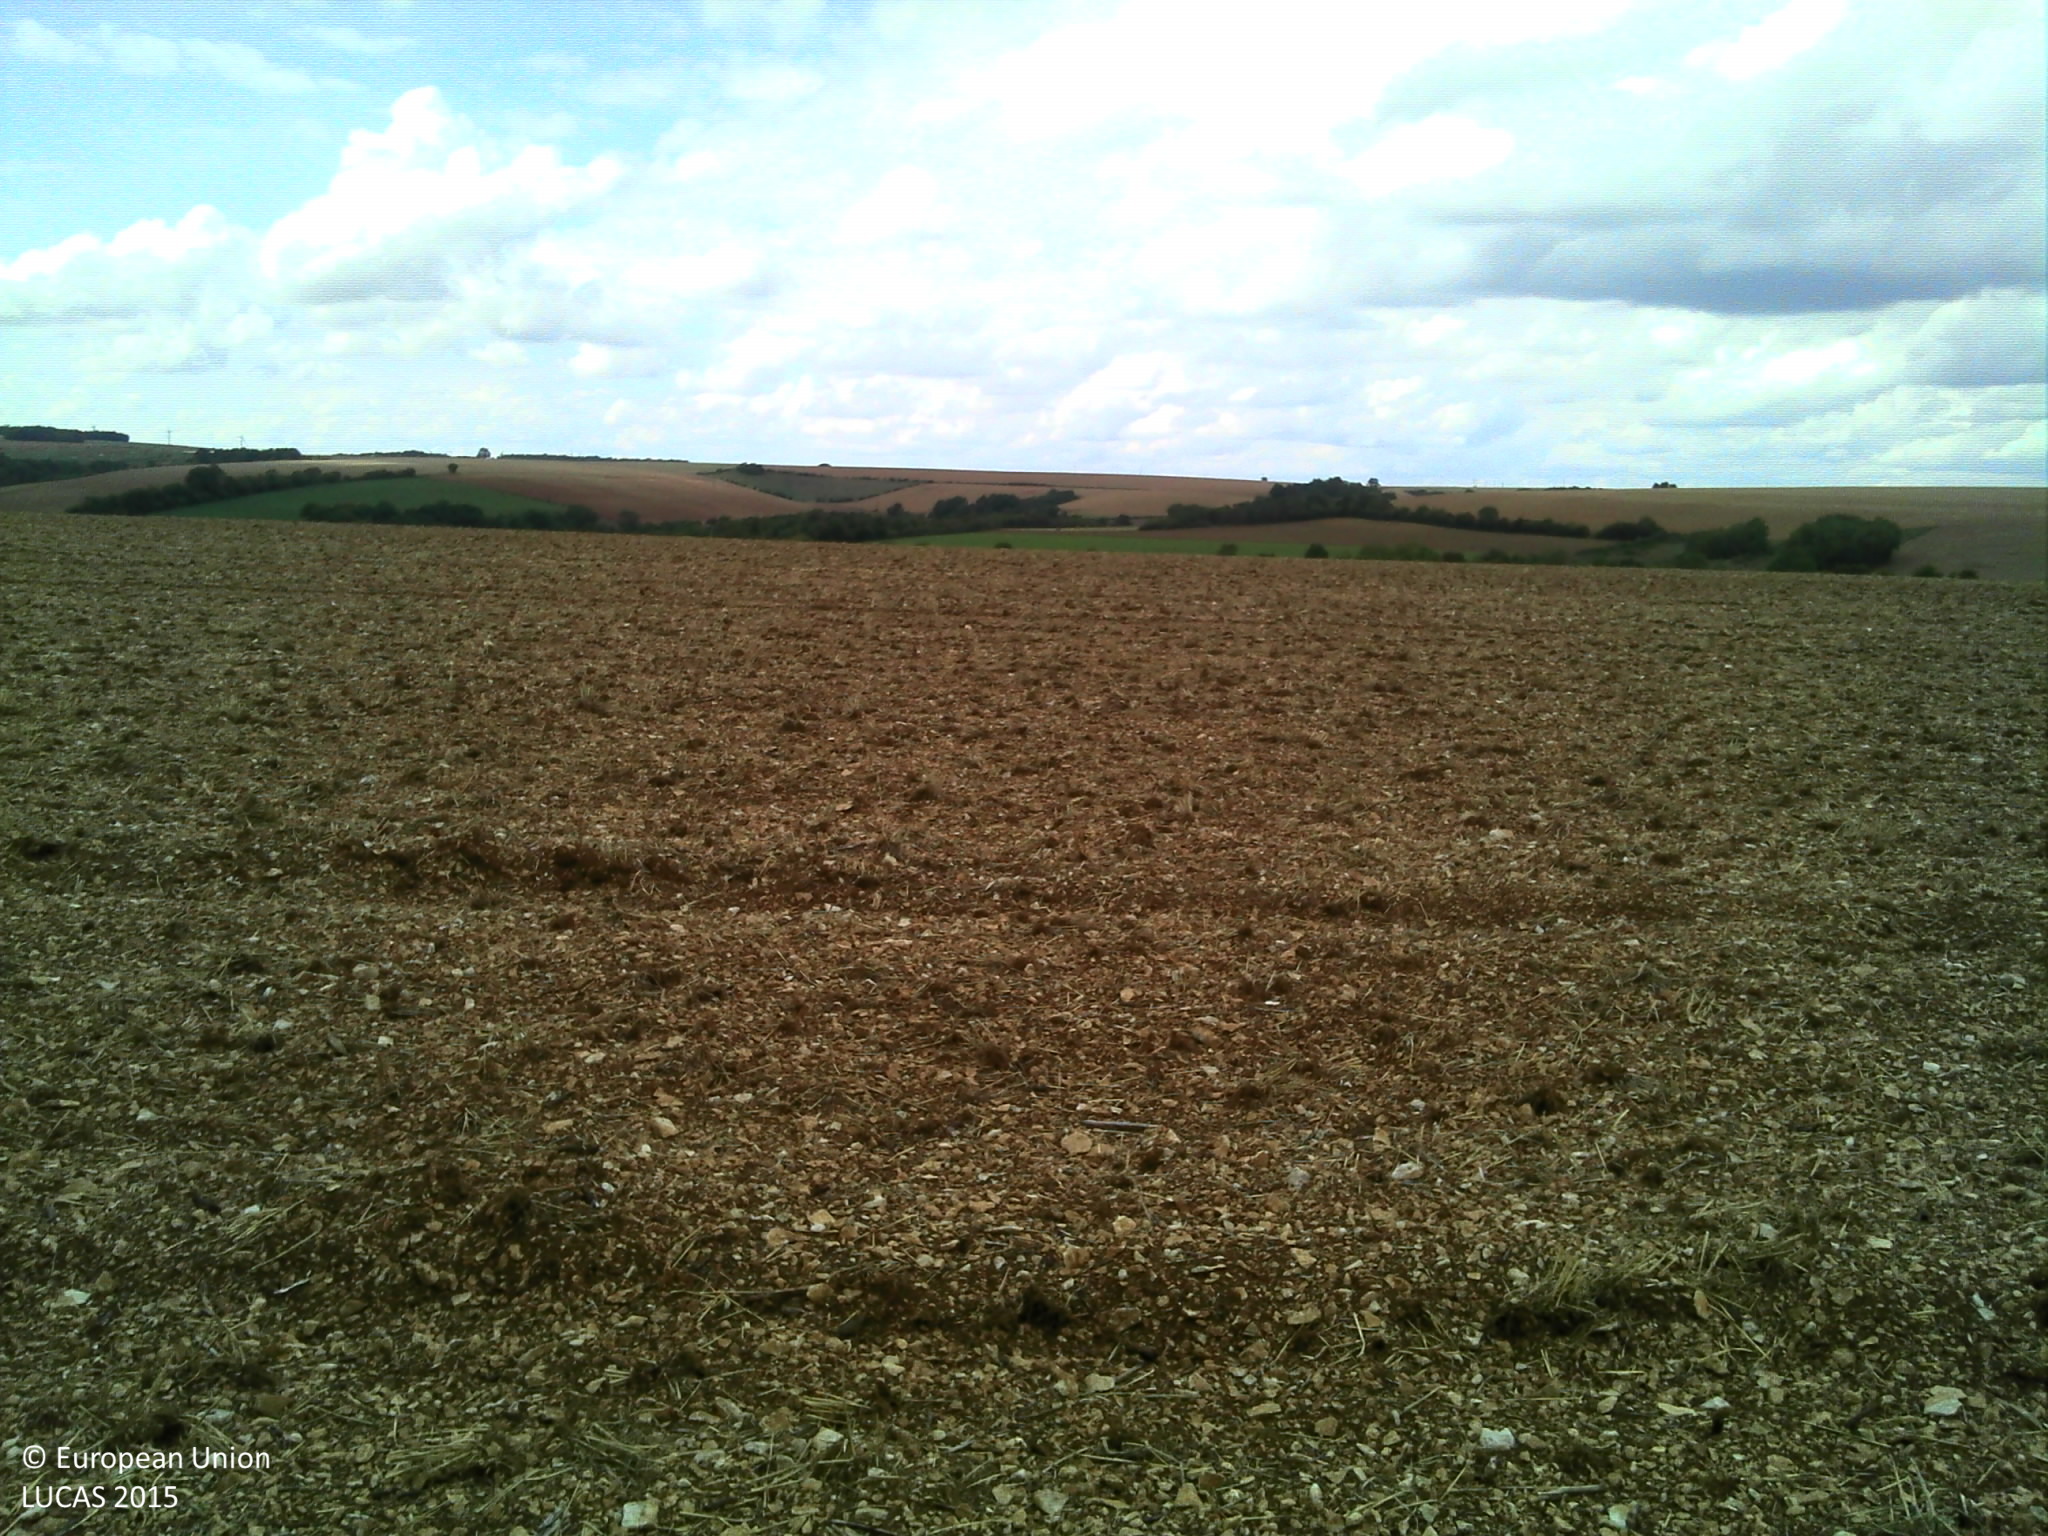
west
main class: Cropland
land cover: Durum wheat
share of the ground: > 75 %
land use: Agriculture (excluding fallow land and kitchen gardens)
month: September
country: FR
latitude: 47.6201
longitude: 4.9303
